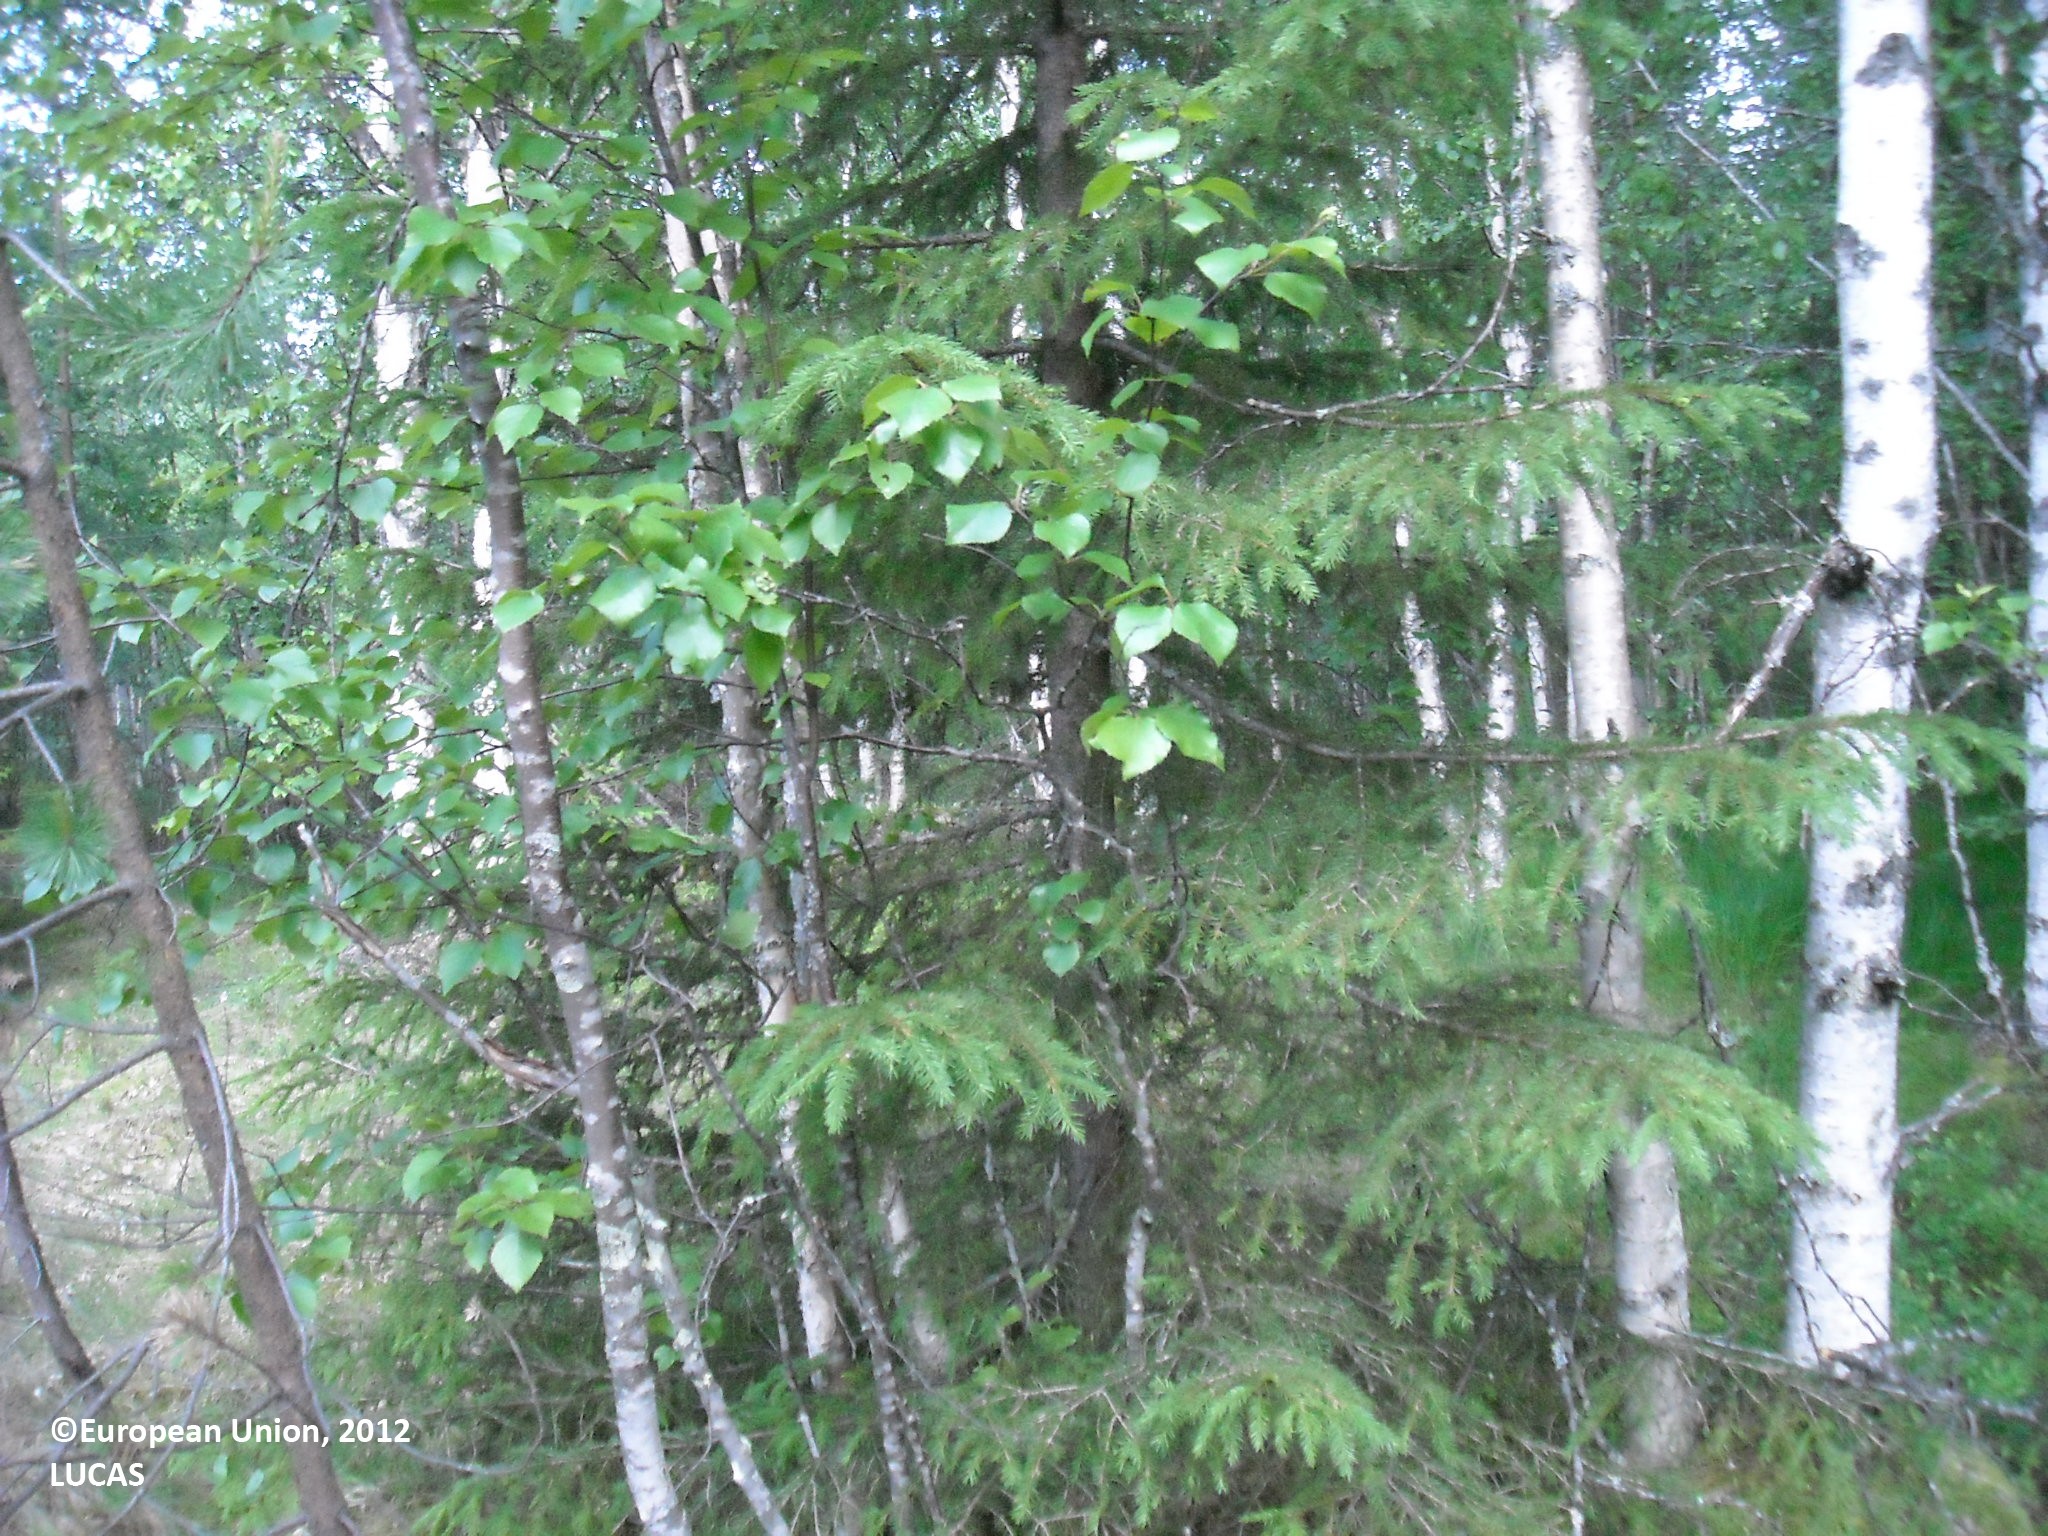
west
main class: Woodland
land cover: Other mixed woodland
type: mire and swamp forests
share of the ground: 50 - 75 %
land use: Forestry
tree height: > 5 m
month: July
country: FI
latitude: 64.6769
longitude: 27.6850
